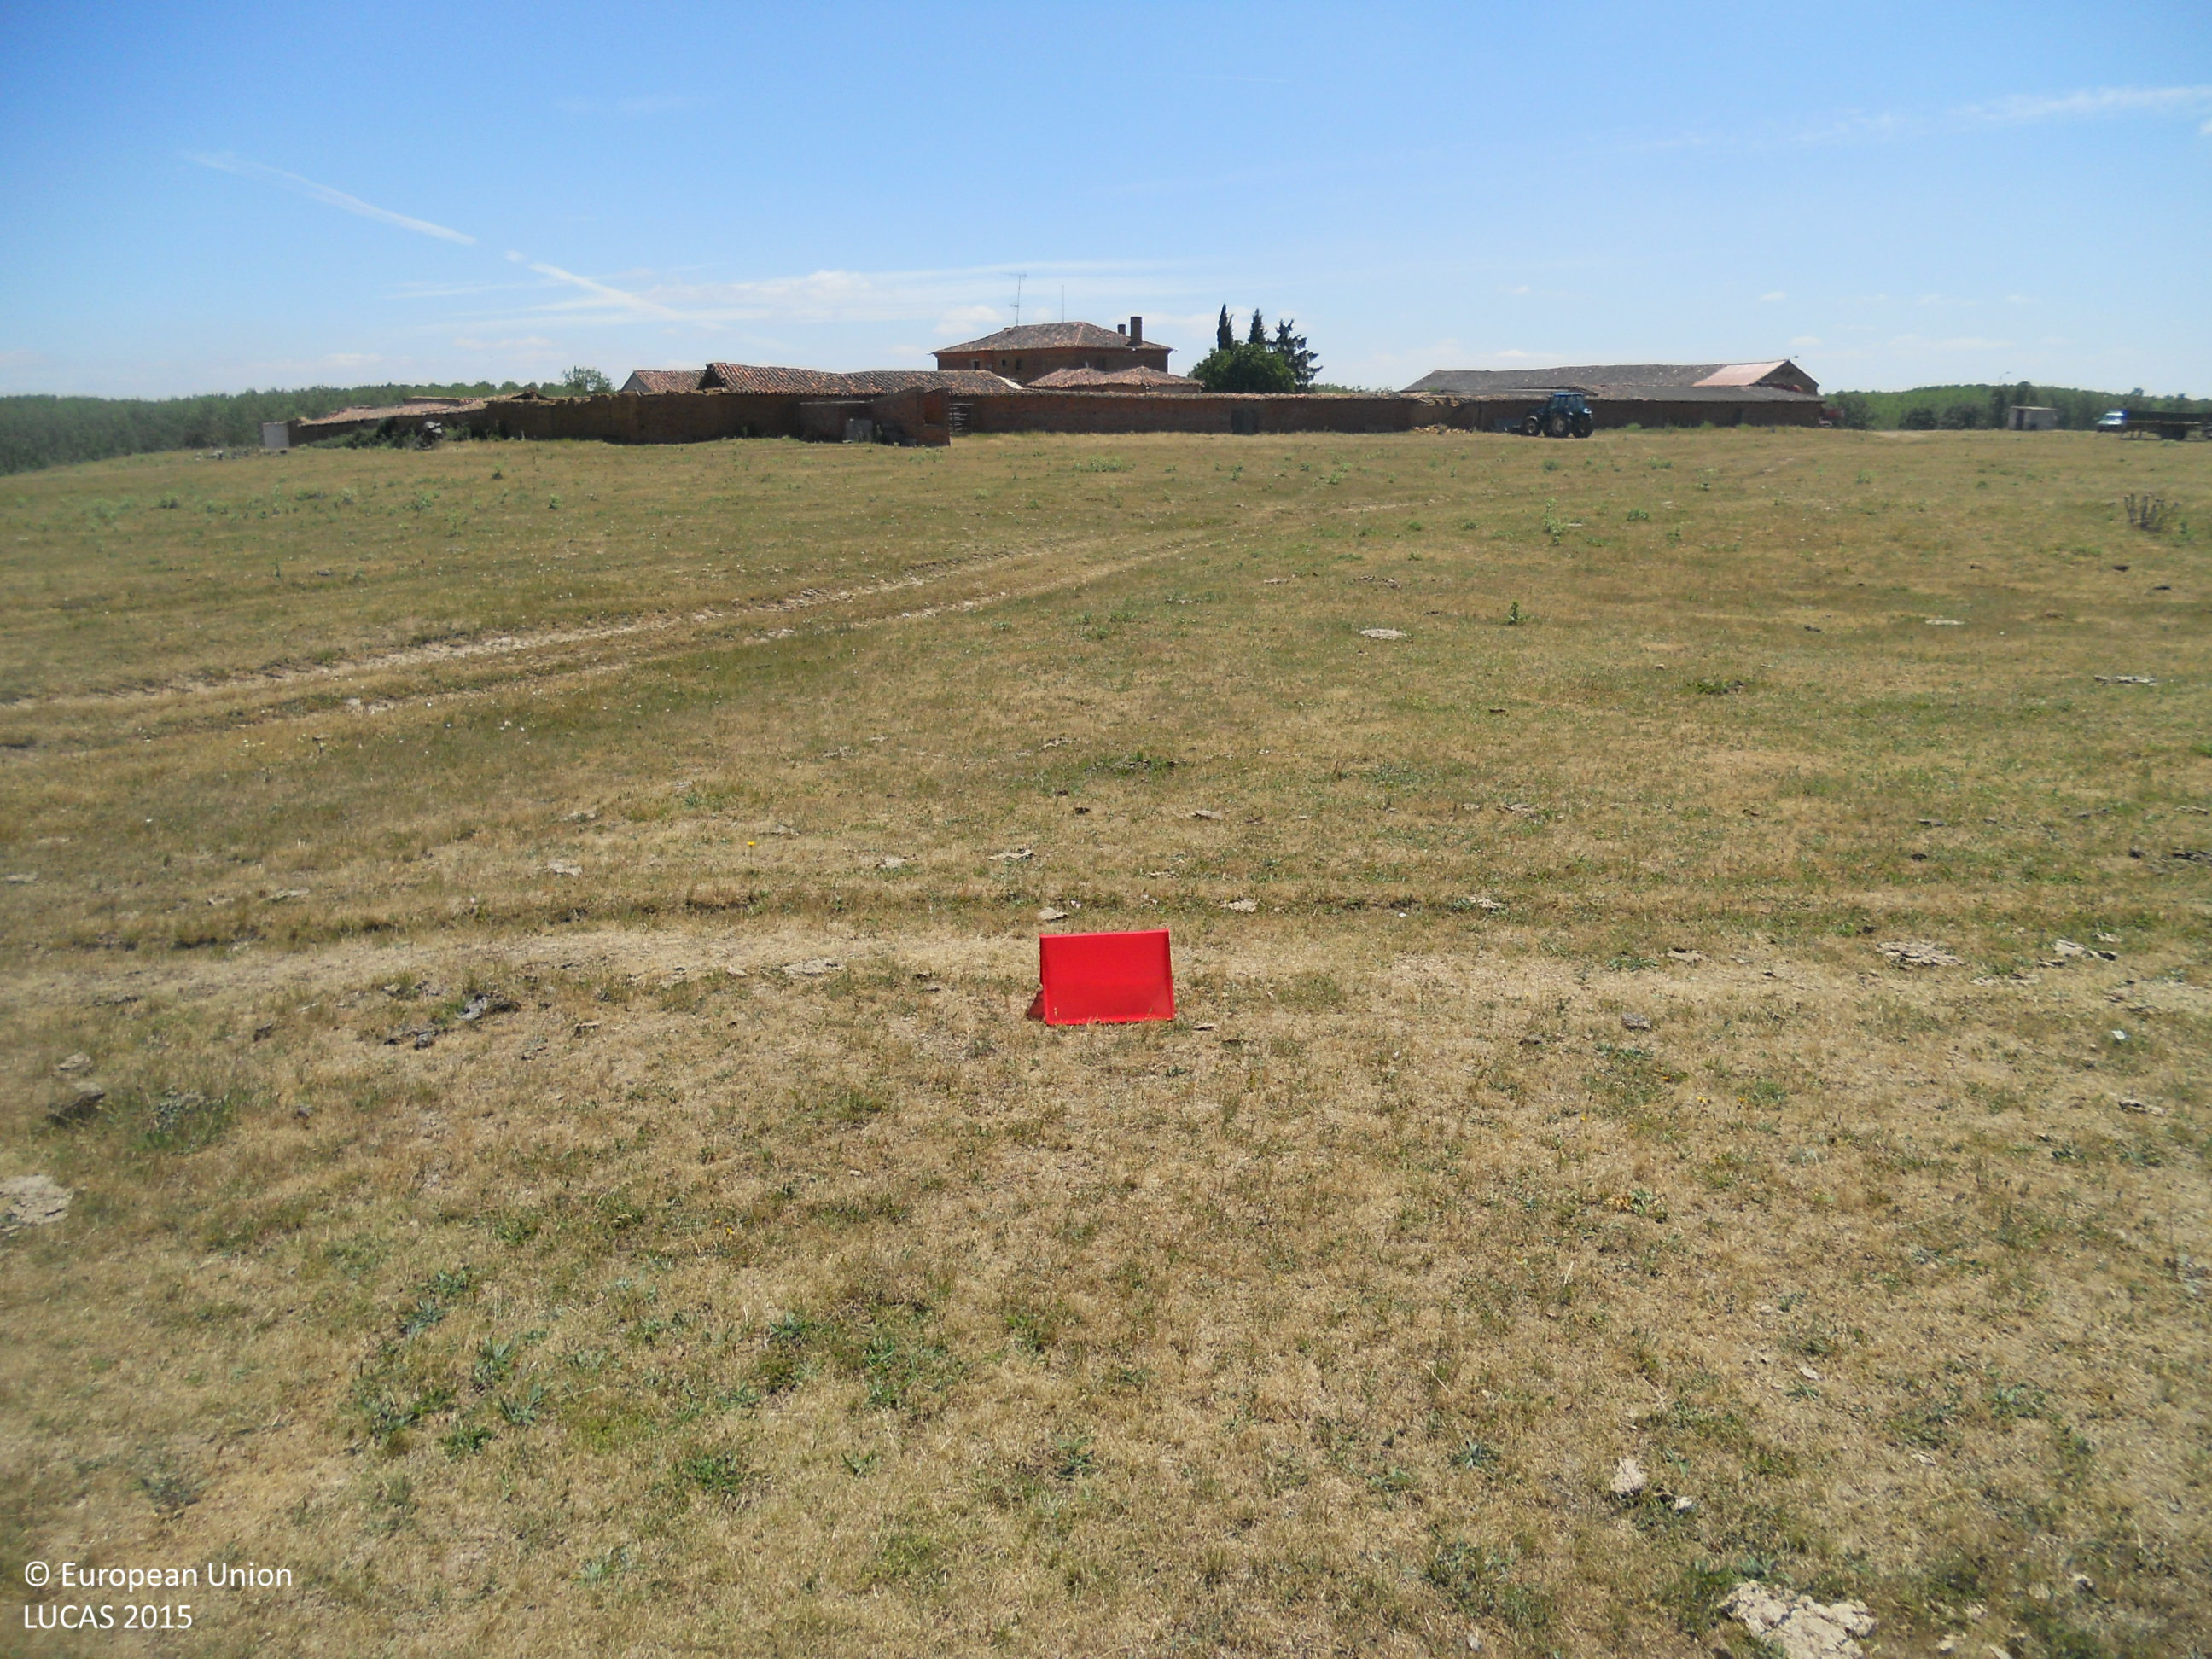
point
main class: Grassland
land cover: Grassland without tree/shrub cover
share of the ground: > 75 %
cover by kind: herbaceous plants 100 %
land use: Agriculture (excluding fallow land and kitchen gardens)
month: June
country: ES
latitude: 42.3687
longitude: -4.7843
